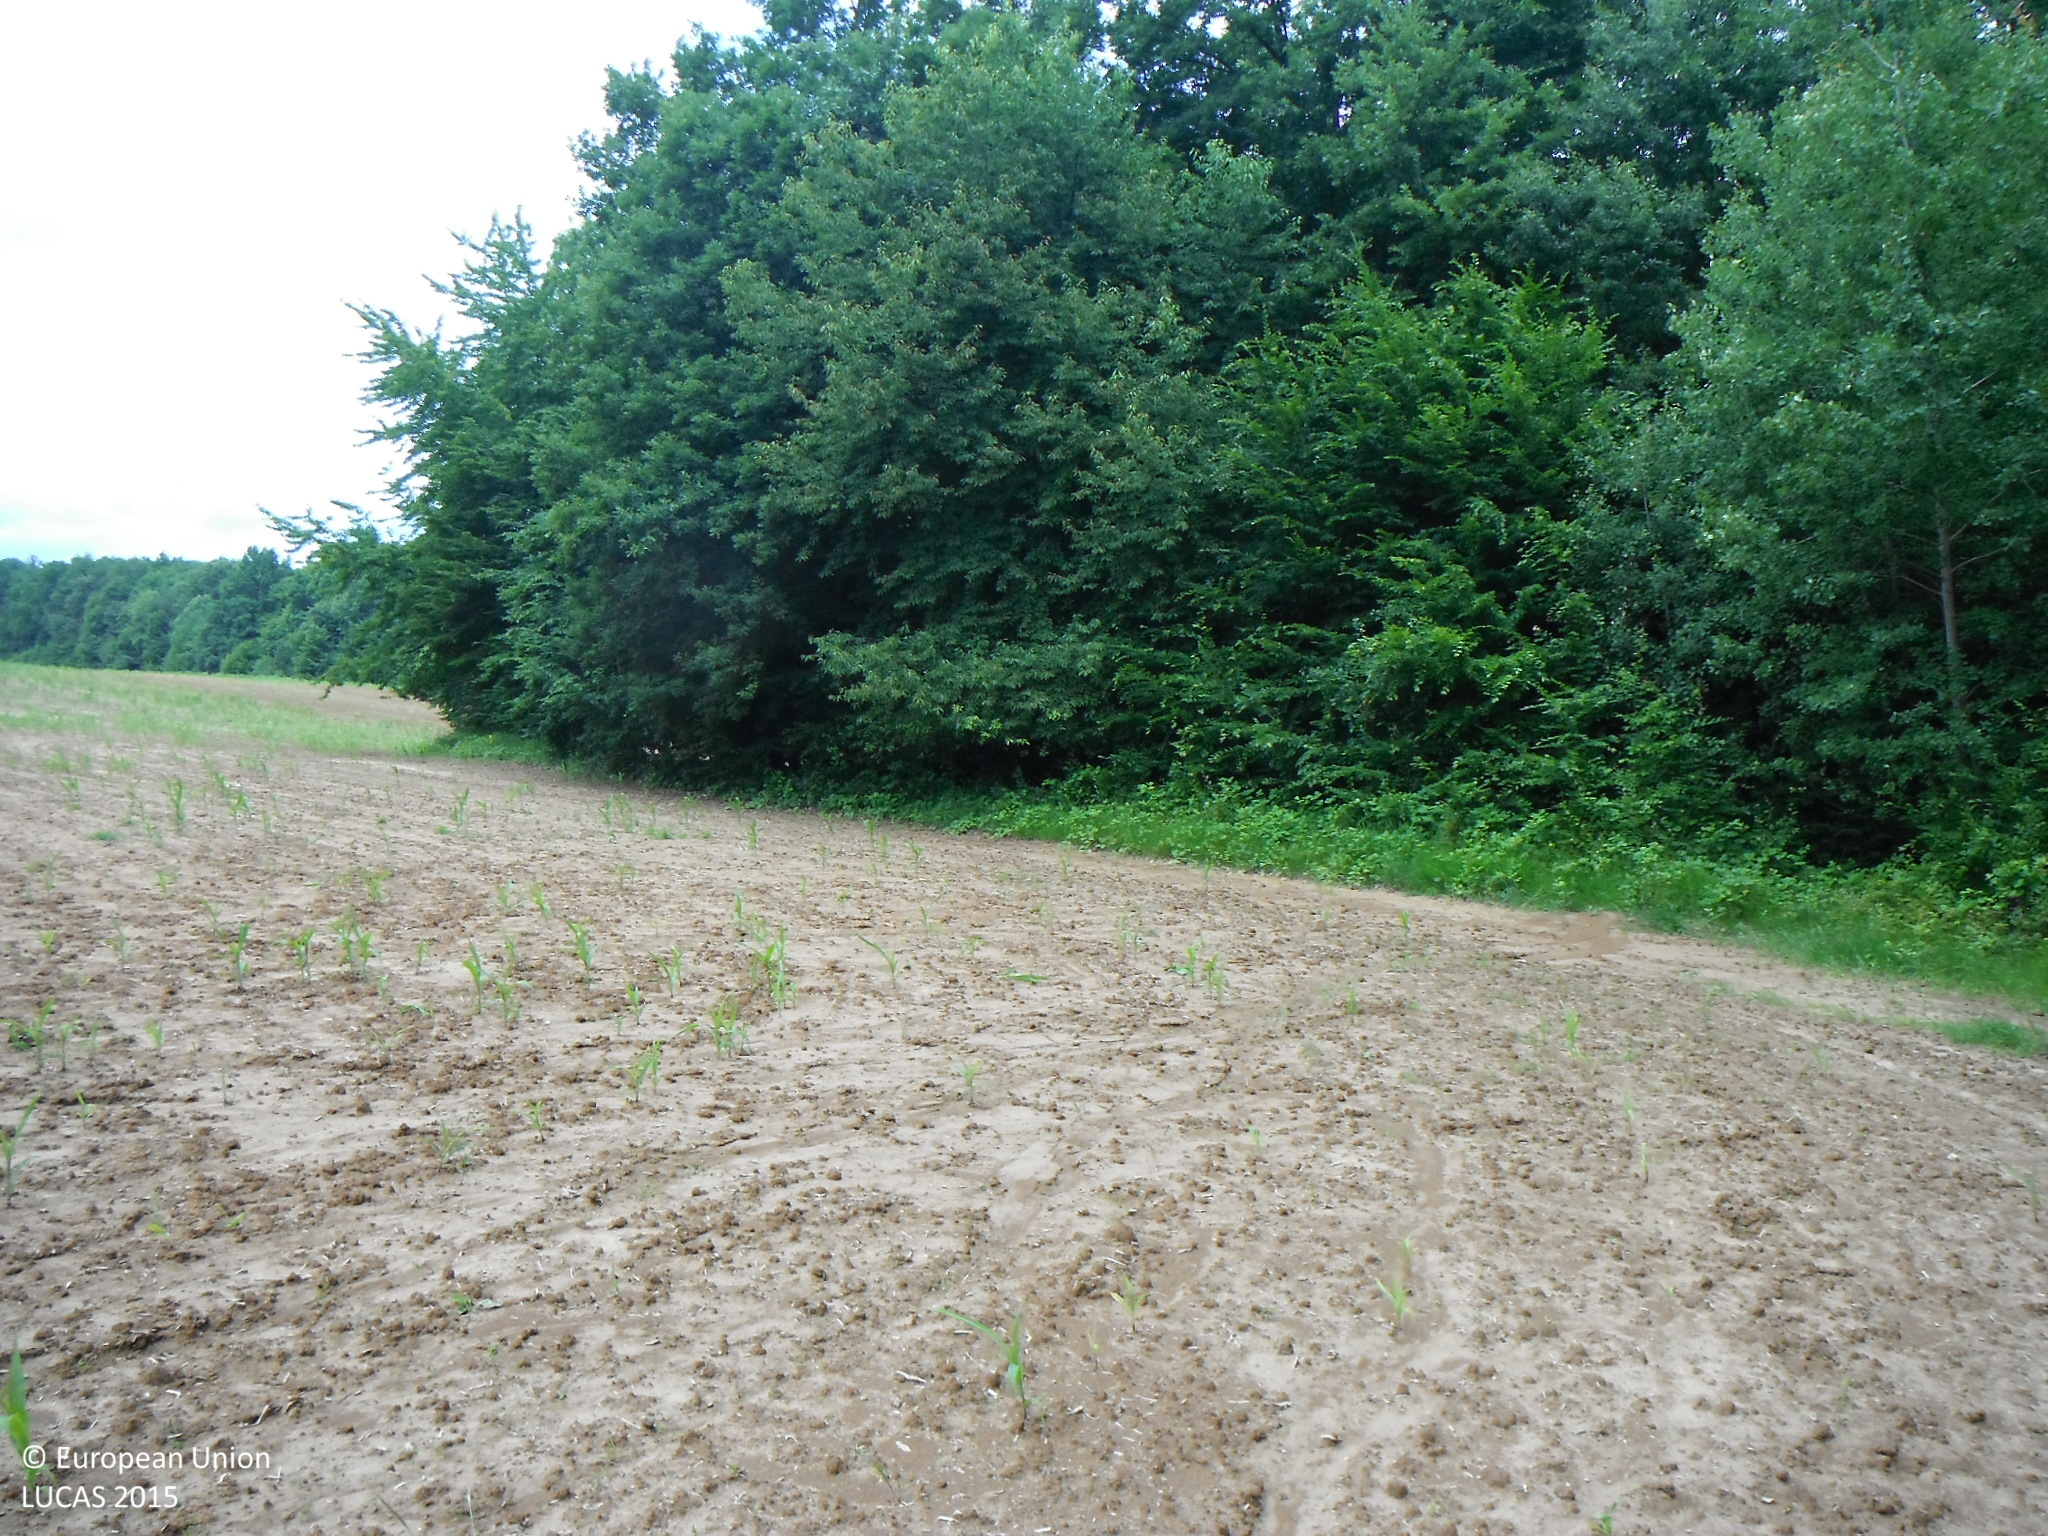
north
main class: Cropland
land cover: Maize
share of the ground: < 10 %
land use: Agriculture (excluding fallow land and kitchen gardens)
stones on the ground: < 10 %
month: June
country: SK
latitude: 48.4644
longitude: 19.9148
